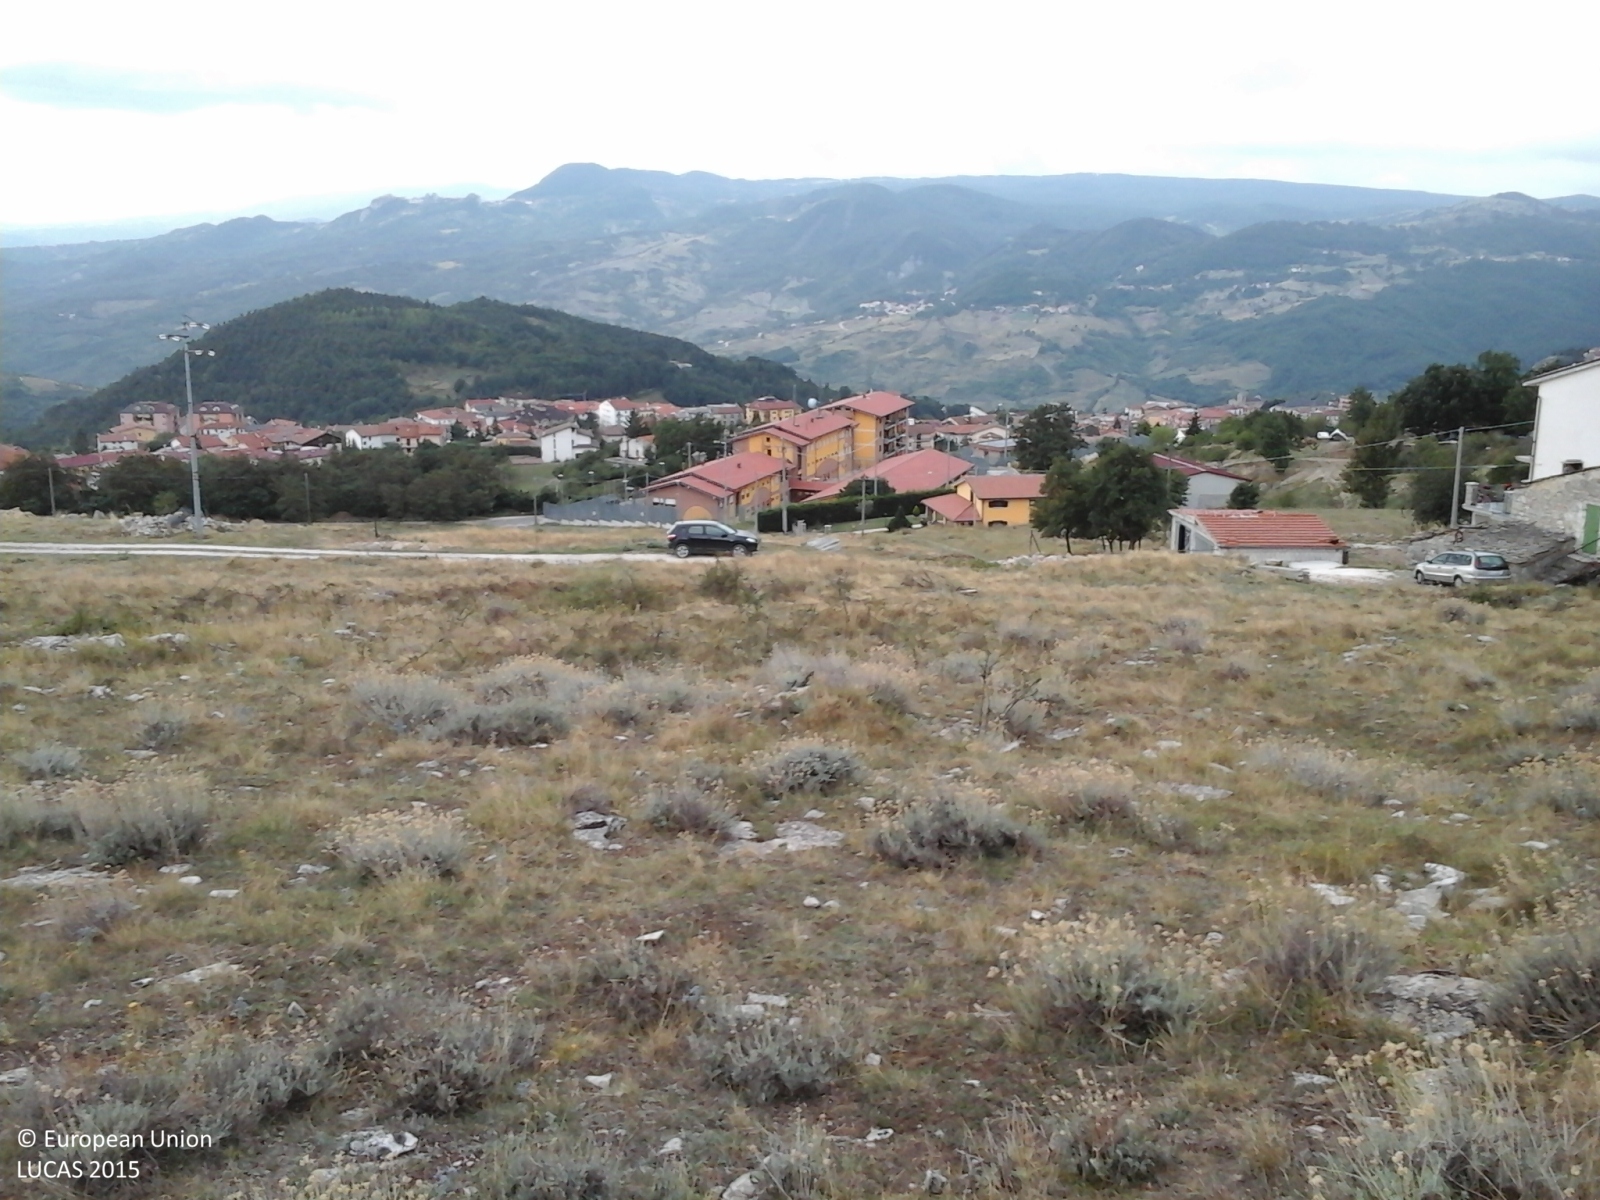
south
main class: Grassland
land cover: Grassland without tree/shrub cover
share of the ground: > 75 %
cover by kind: herbaceous plants 100 %
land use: Agriculture (excluding fallow land and kitchen gardens)
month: August
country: IT
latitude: 41.8176
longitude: 14.3793
